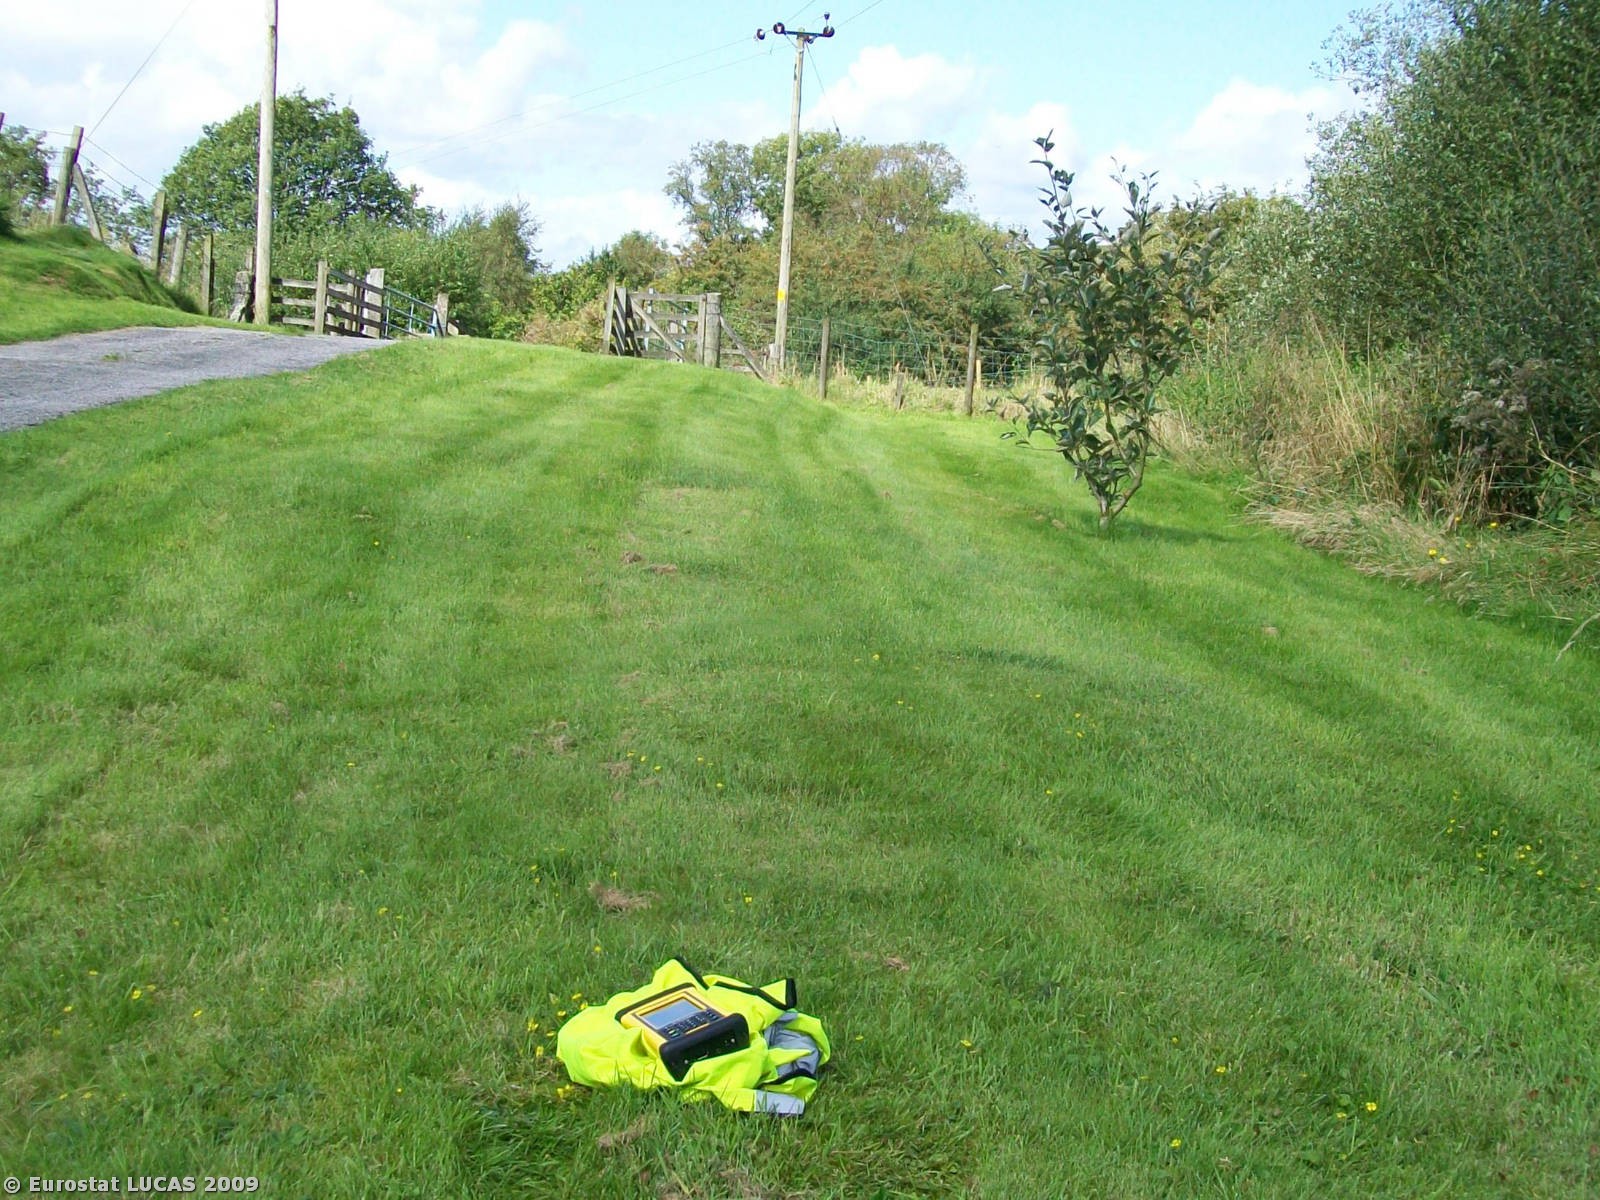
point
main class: Grassland
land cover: Grassland with sparse tree/shrub cover
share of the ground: < 10 %
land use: Residential
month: August
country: GB
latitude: 55.1087
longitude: -4.1226
